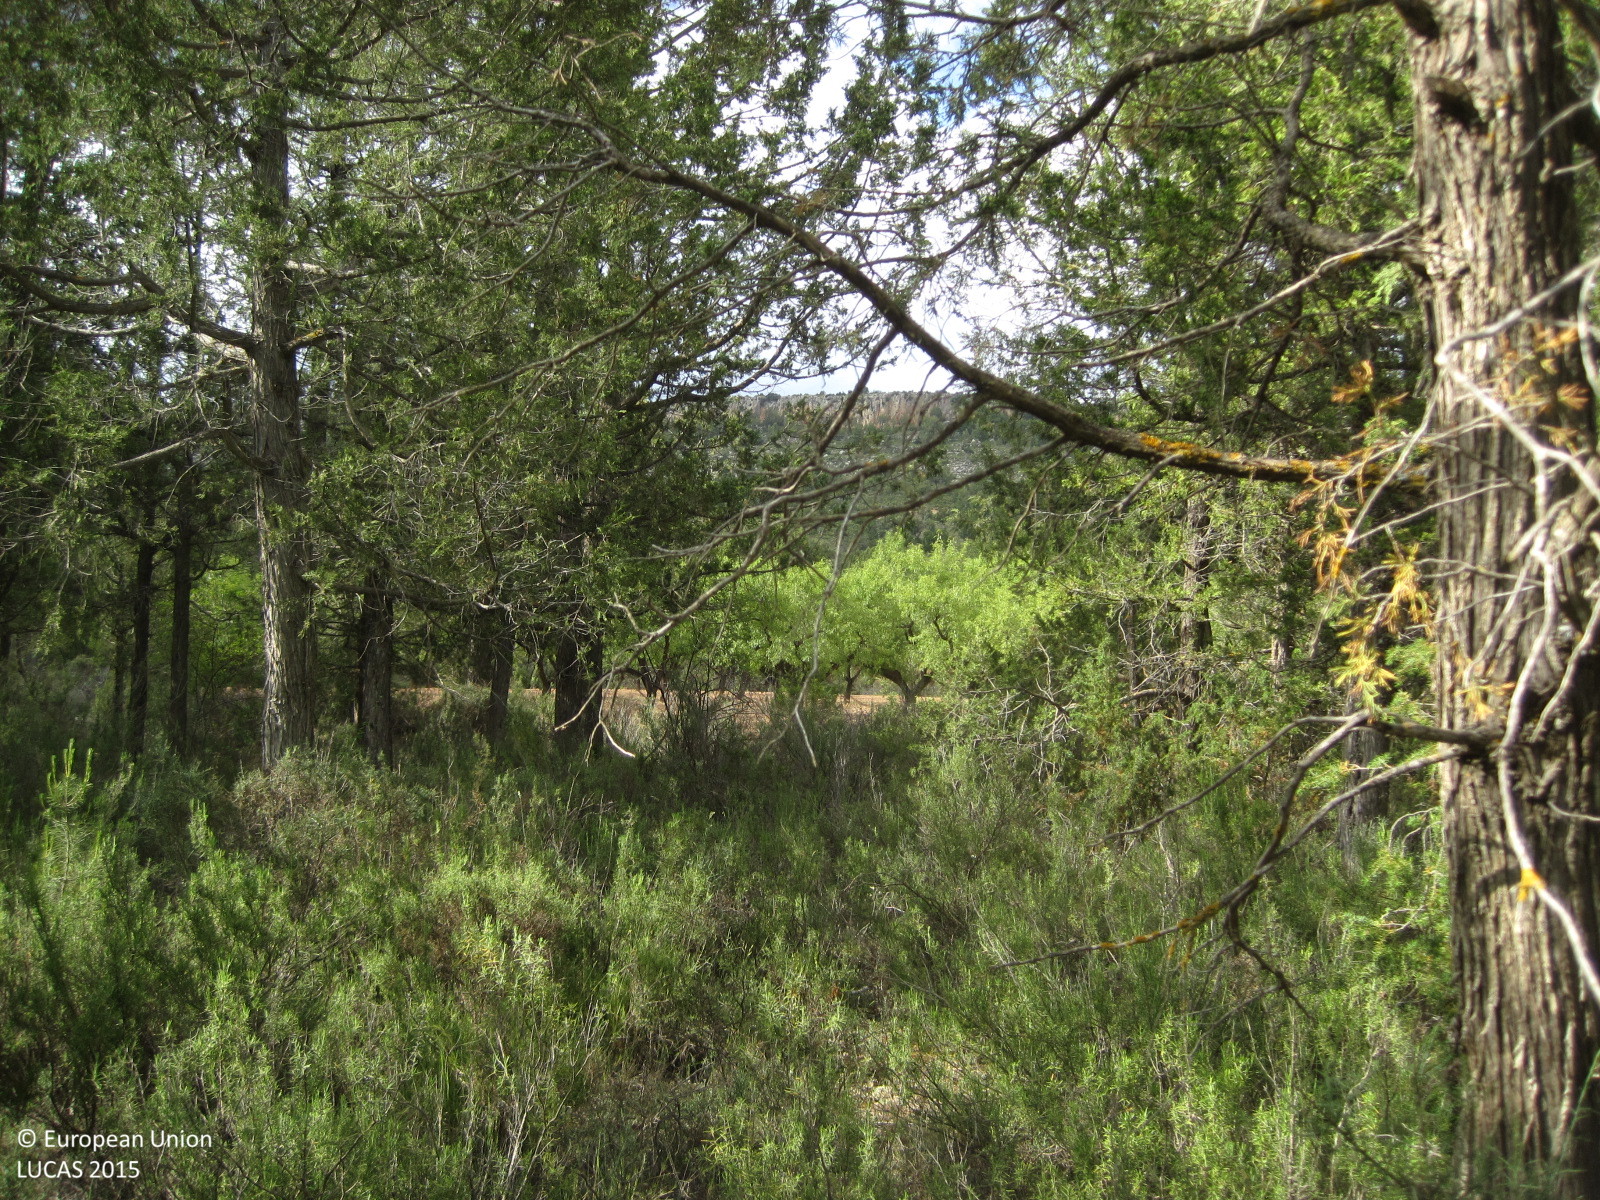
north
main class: Woodland
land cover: Other coniferous woodland
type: coniferous forest of the mediterranean region
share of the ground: 50 - 75 %
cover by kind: coniferous forest trees 55 %, shrubs 25 %, herbaceous plants 15 %, lichens and mosses 5 %
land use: Forestry
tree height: > 5 m
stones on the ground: 25 - 50 %
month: June
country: ES
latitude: 39.9573
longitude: -0.9977
